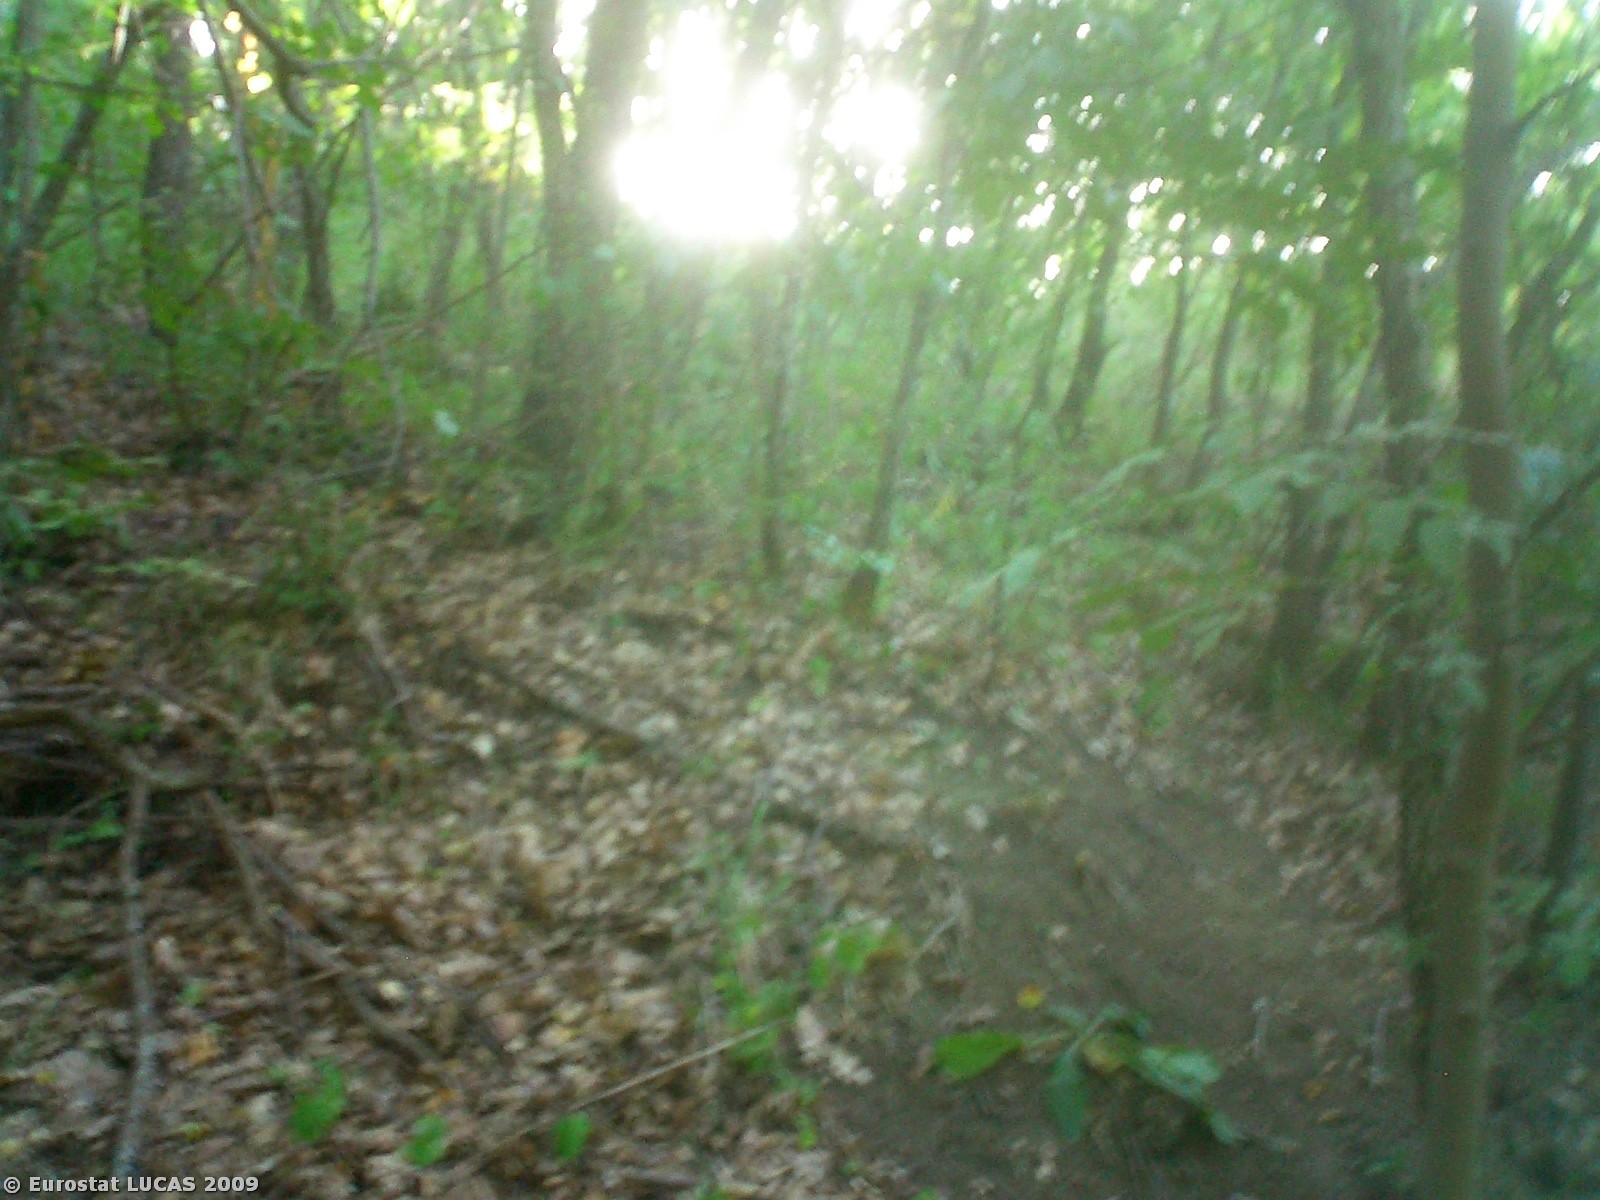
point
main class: Woodland
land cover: Mixed woodland
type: mesophytic deciduous forest
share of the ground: > 75 %
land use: Forestry
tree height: > 5 m
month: July
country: IT
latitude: 44.2655
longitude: 11.6373
